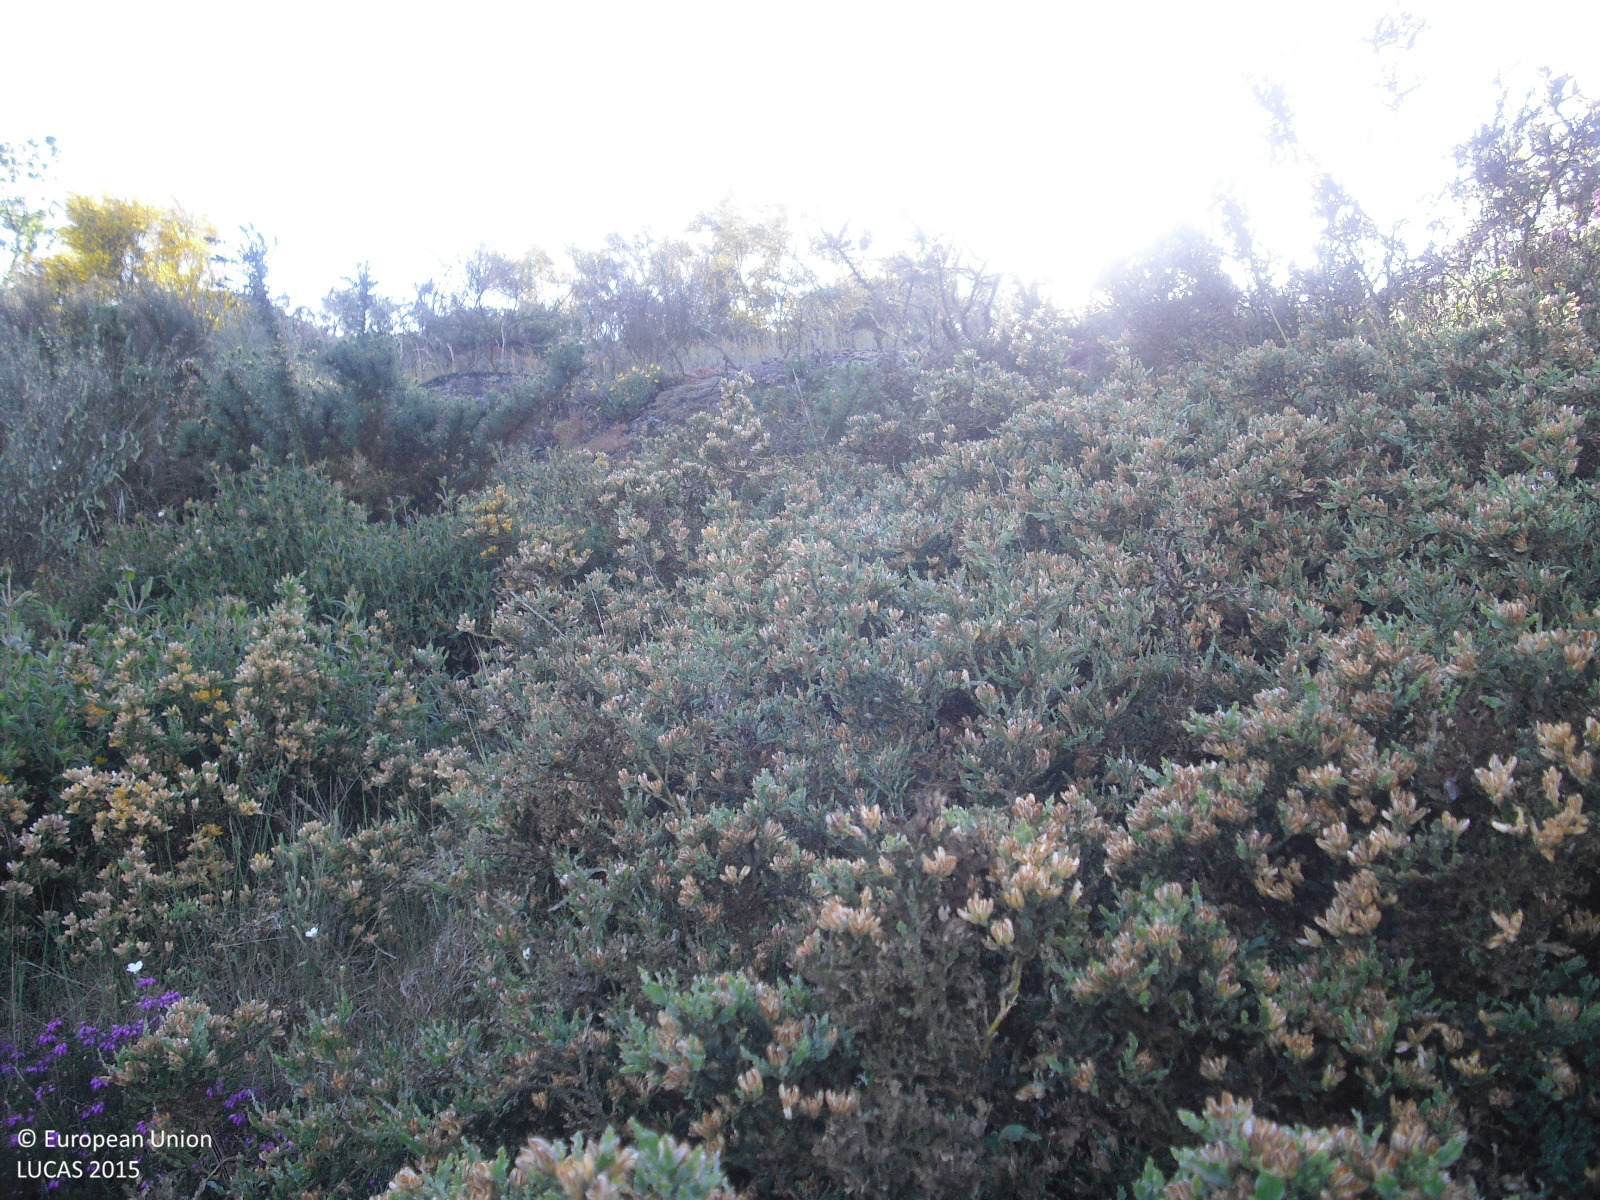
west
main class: Shrubland
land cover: Shrubland with sparse tree cover
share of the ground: > 75 %
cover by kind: shrubs 85 %, consolidated bare surface 10 %, broadleaved forest trees 5 %
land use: Semi-natural and natural areas not in use
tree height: > 5 m
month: May
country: ES
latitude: 42.0799
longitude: -7.6805
